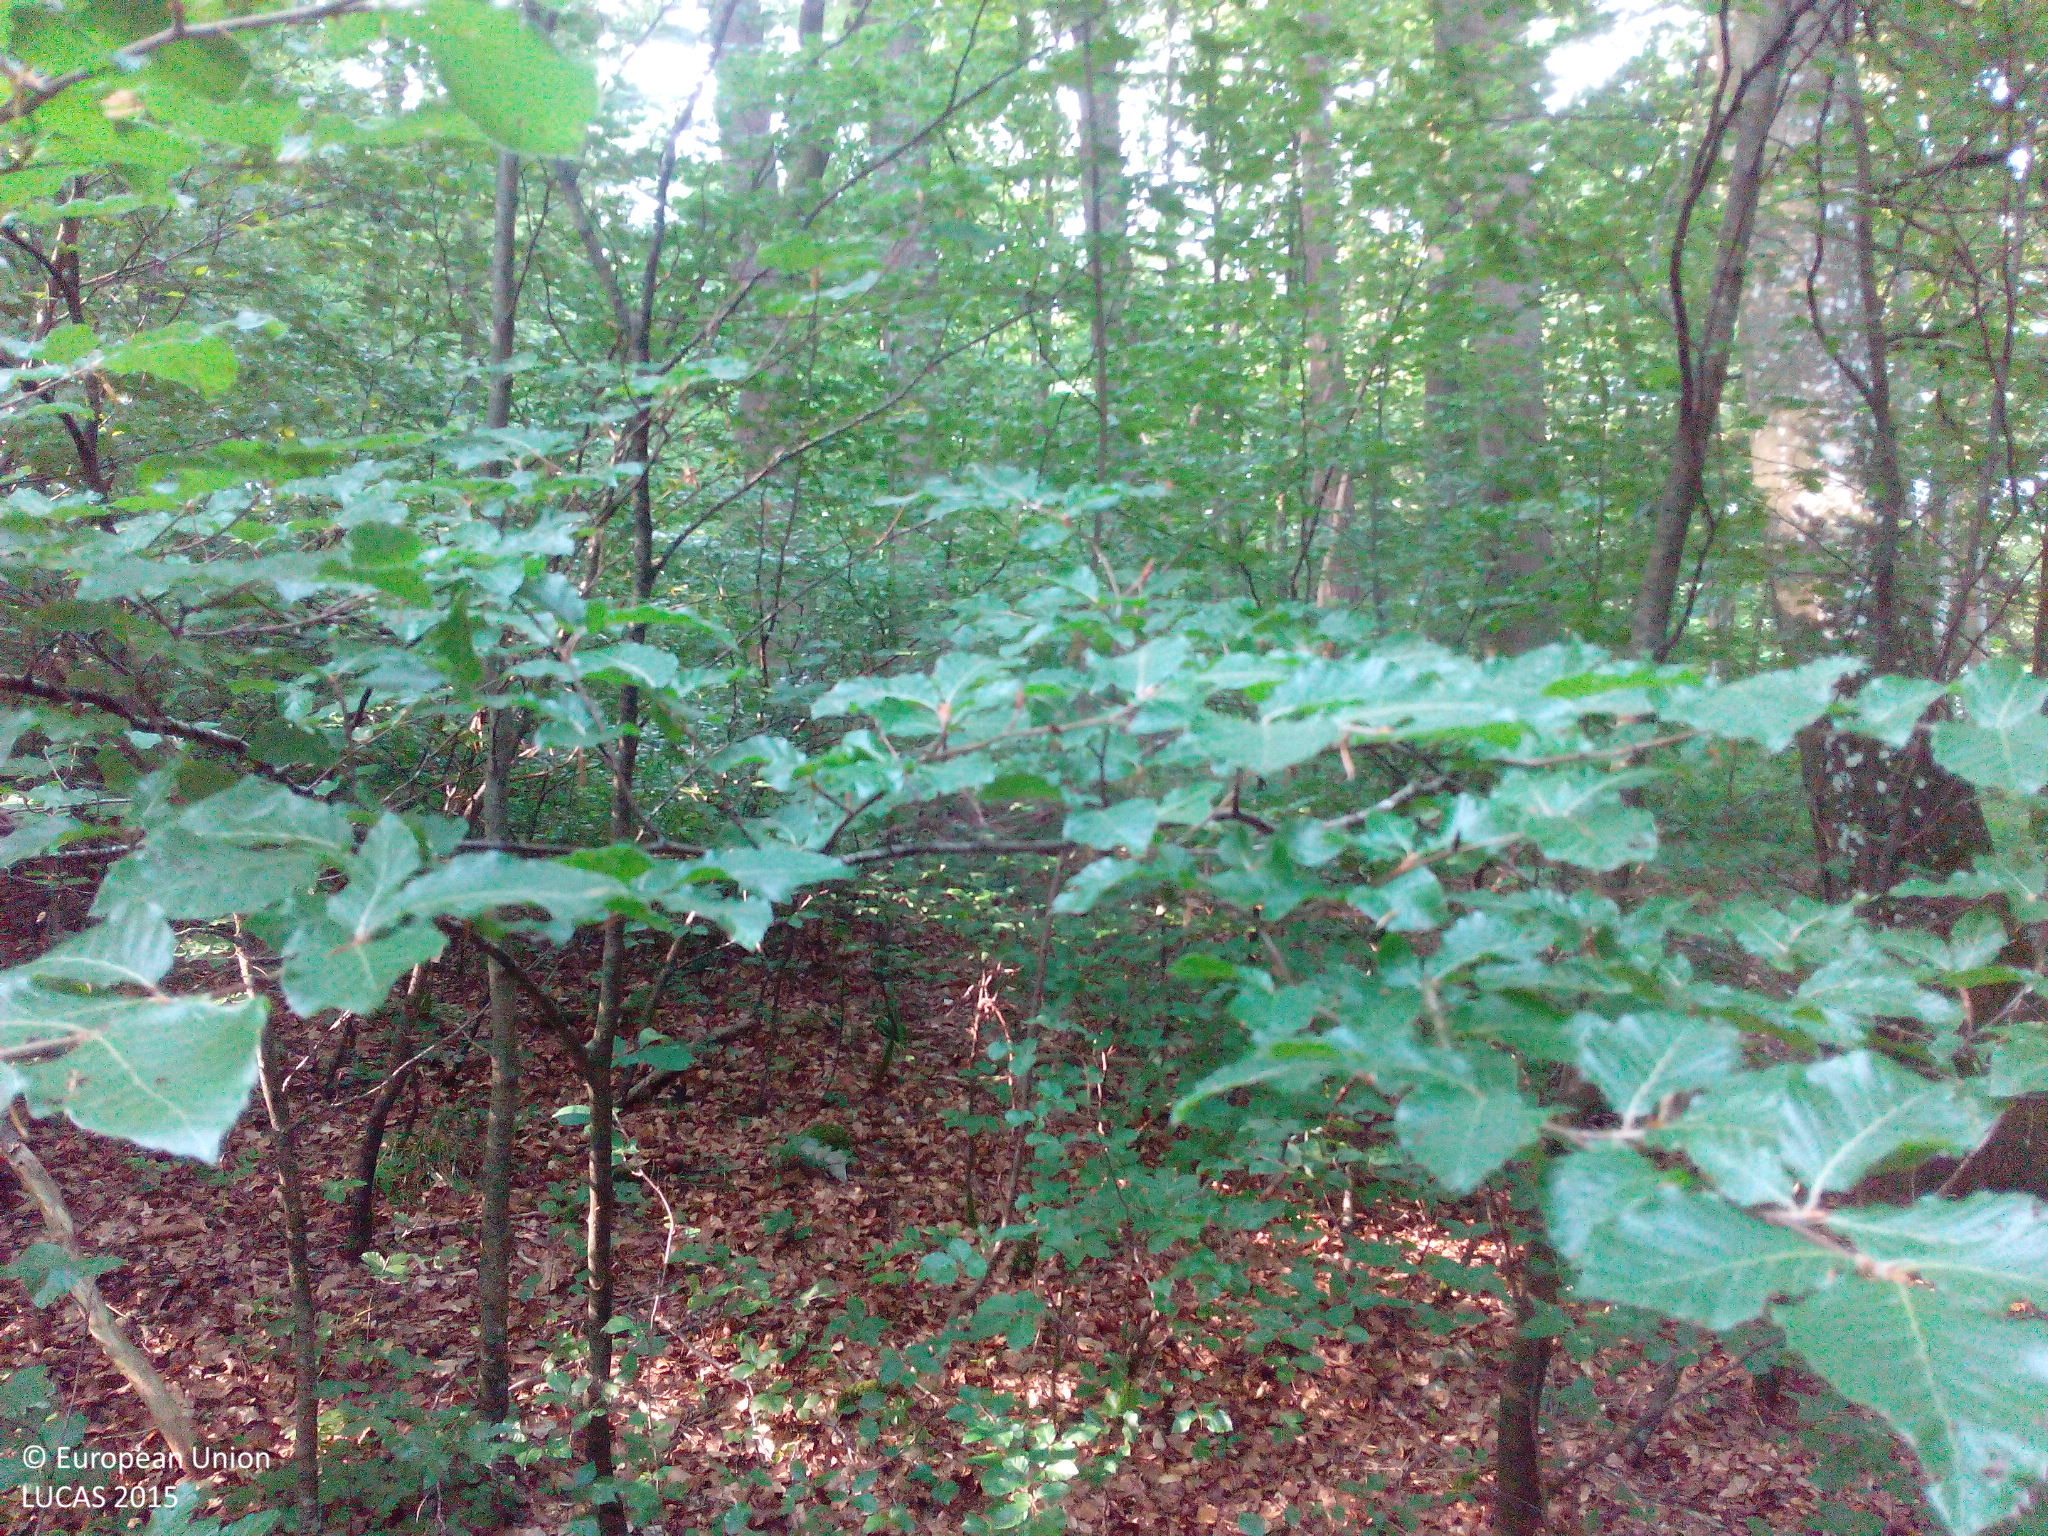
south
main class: Woodland
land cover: Broadleaved woodland
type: mesophytic deciduous forest
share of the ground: > 75 %
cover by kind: broadleaved forest trees 95 %, unconsolidated bare surface 5 %
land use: Forestry
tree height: > 5 m
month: July
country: DE
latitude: 48.1494
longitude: 9.3149
